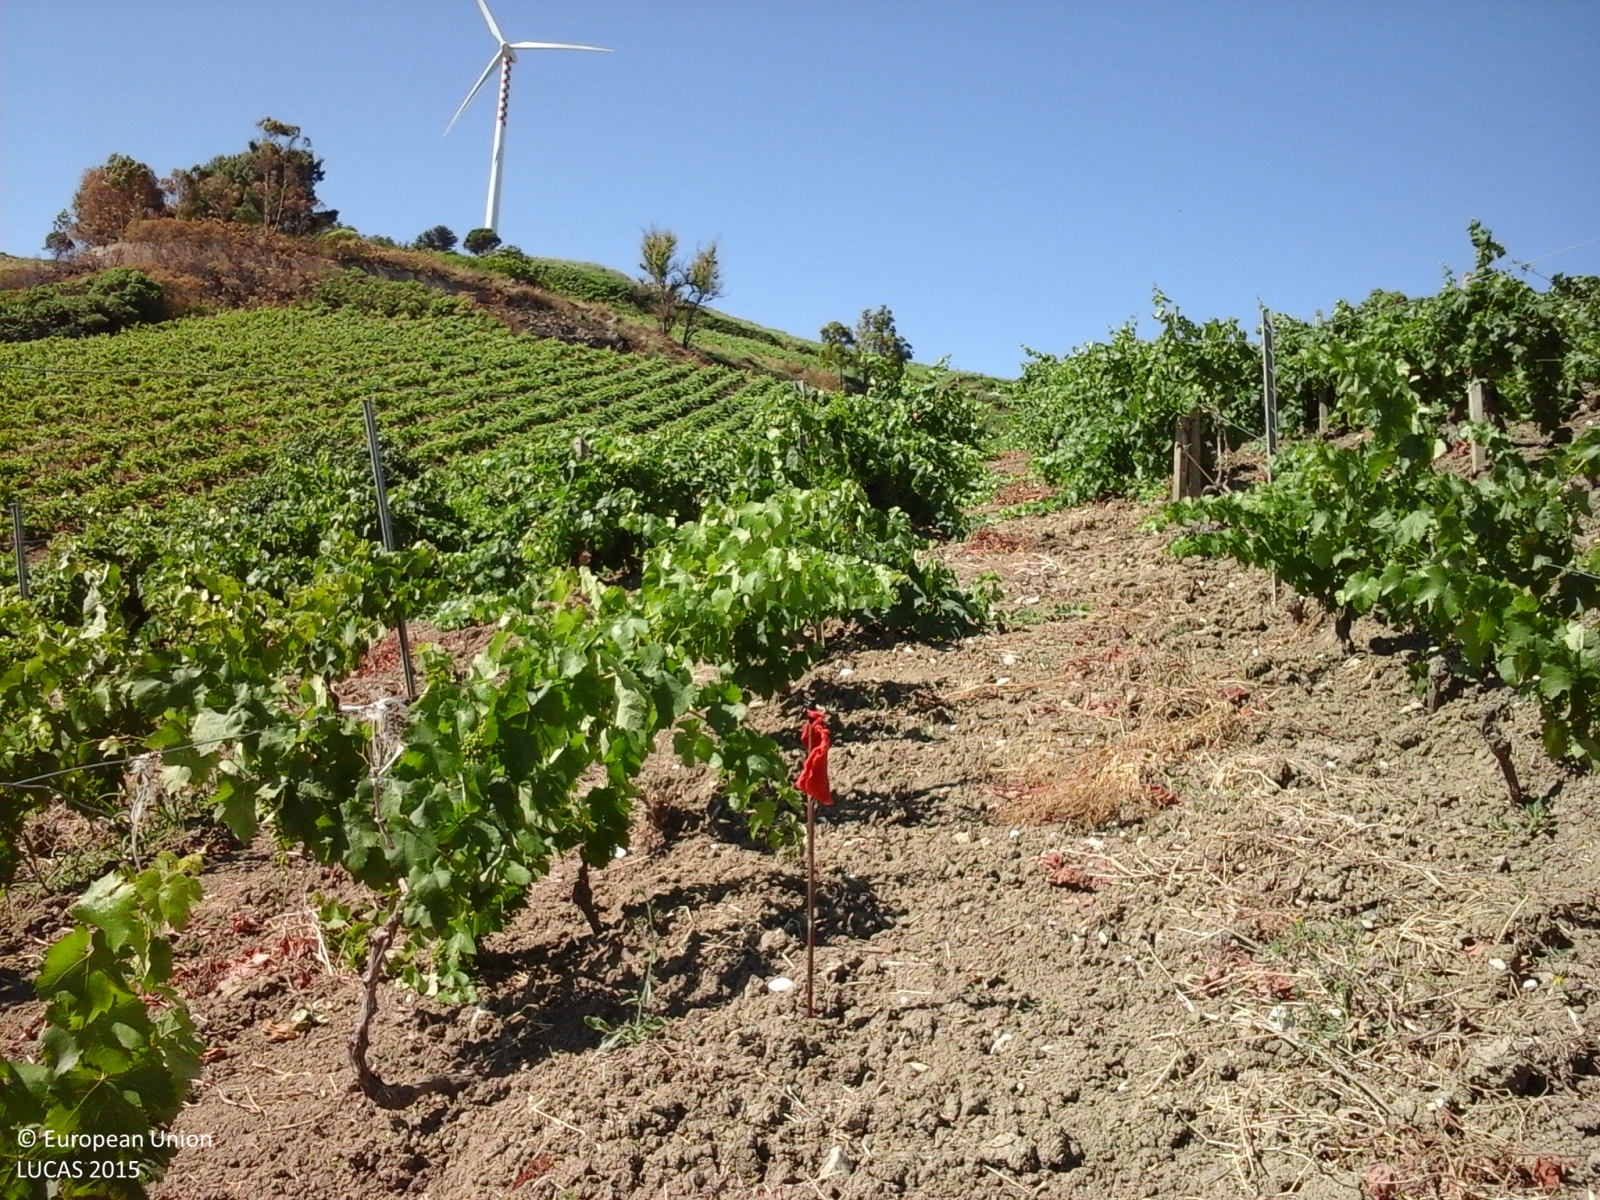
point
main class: Cropland
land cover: Vineyards
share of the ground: 25 - 50 %
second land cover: Other bare soil
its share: > 75 %
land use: Agriculture (excluding fallow land and kitchen gardens)
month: June
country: IT
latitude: 37.7929
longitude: 12.9421
